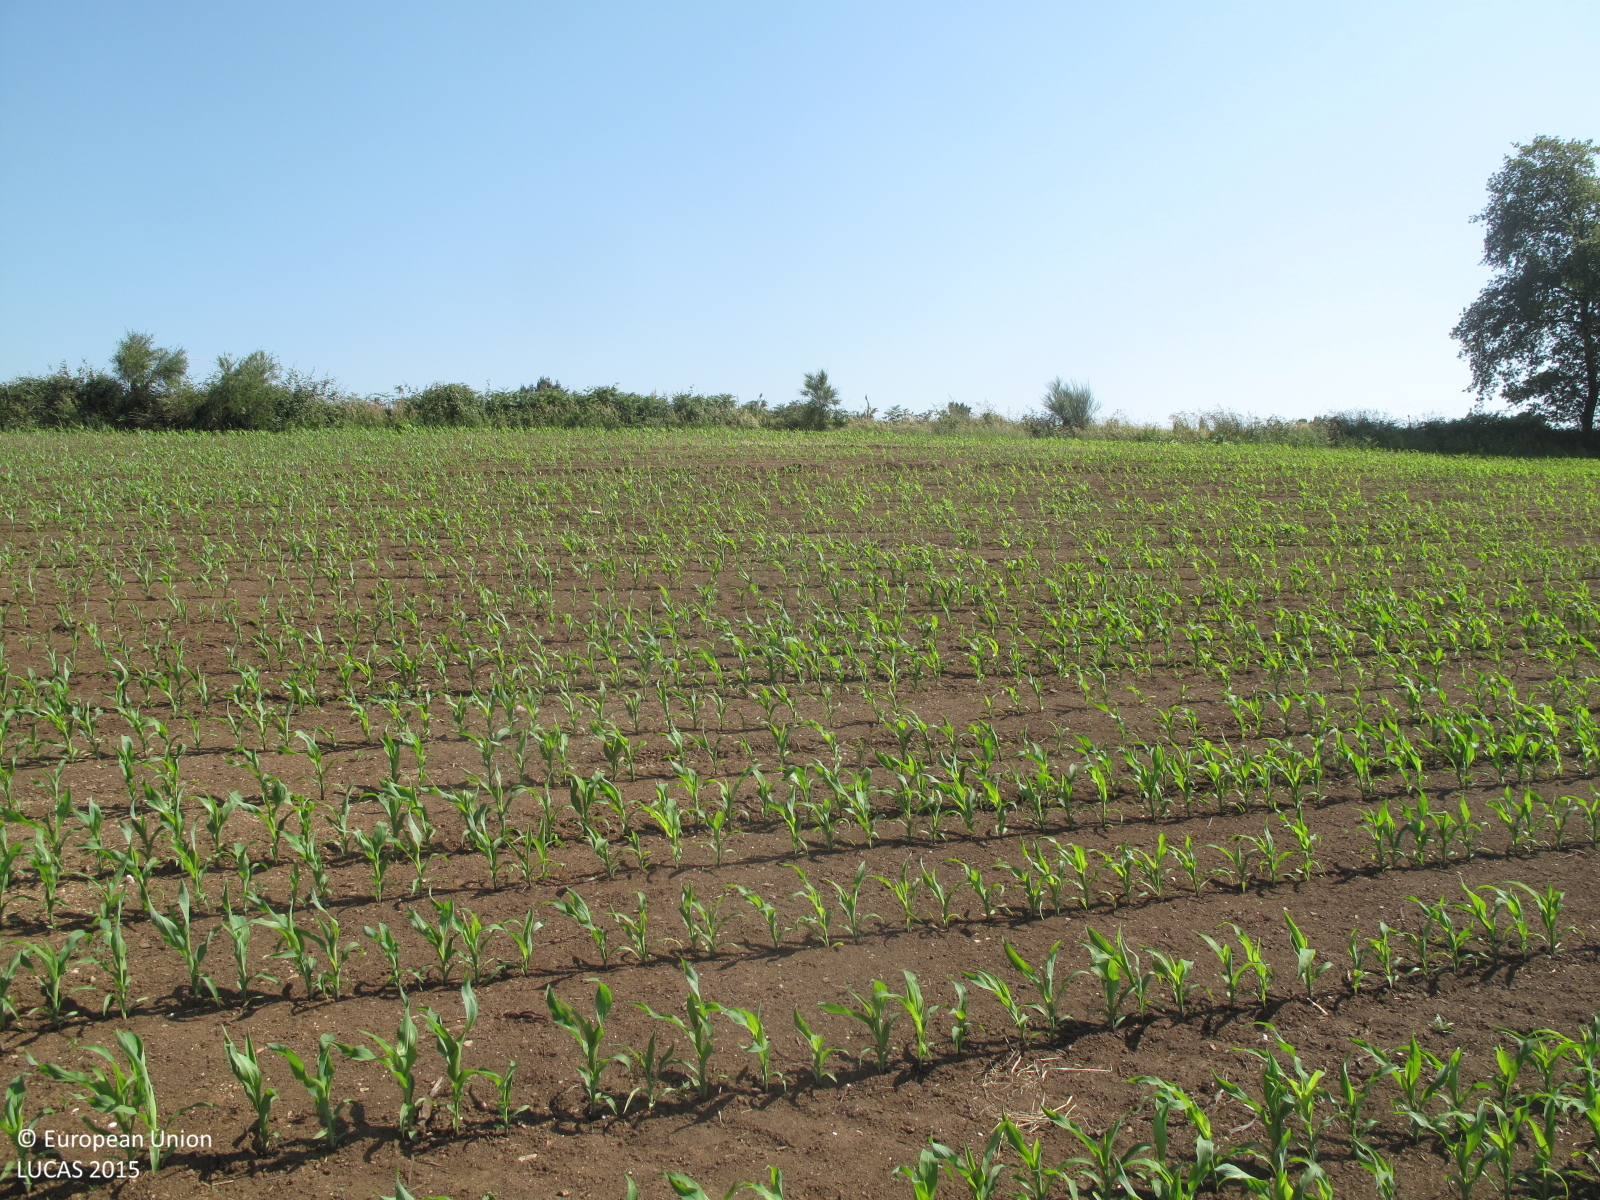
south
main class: Cropland
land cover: Maize
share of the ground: 10 - 25 %
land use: Agriculture (excluding fallow land and kitchen gardens)
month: June
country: ES
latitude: 43.2817
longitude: -7.9735
